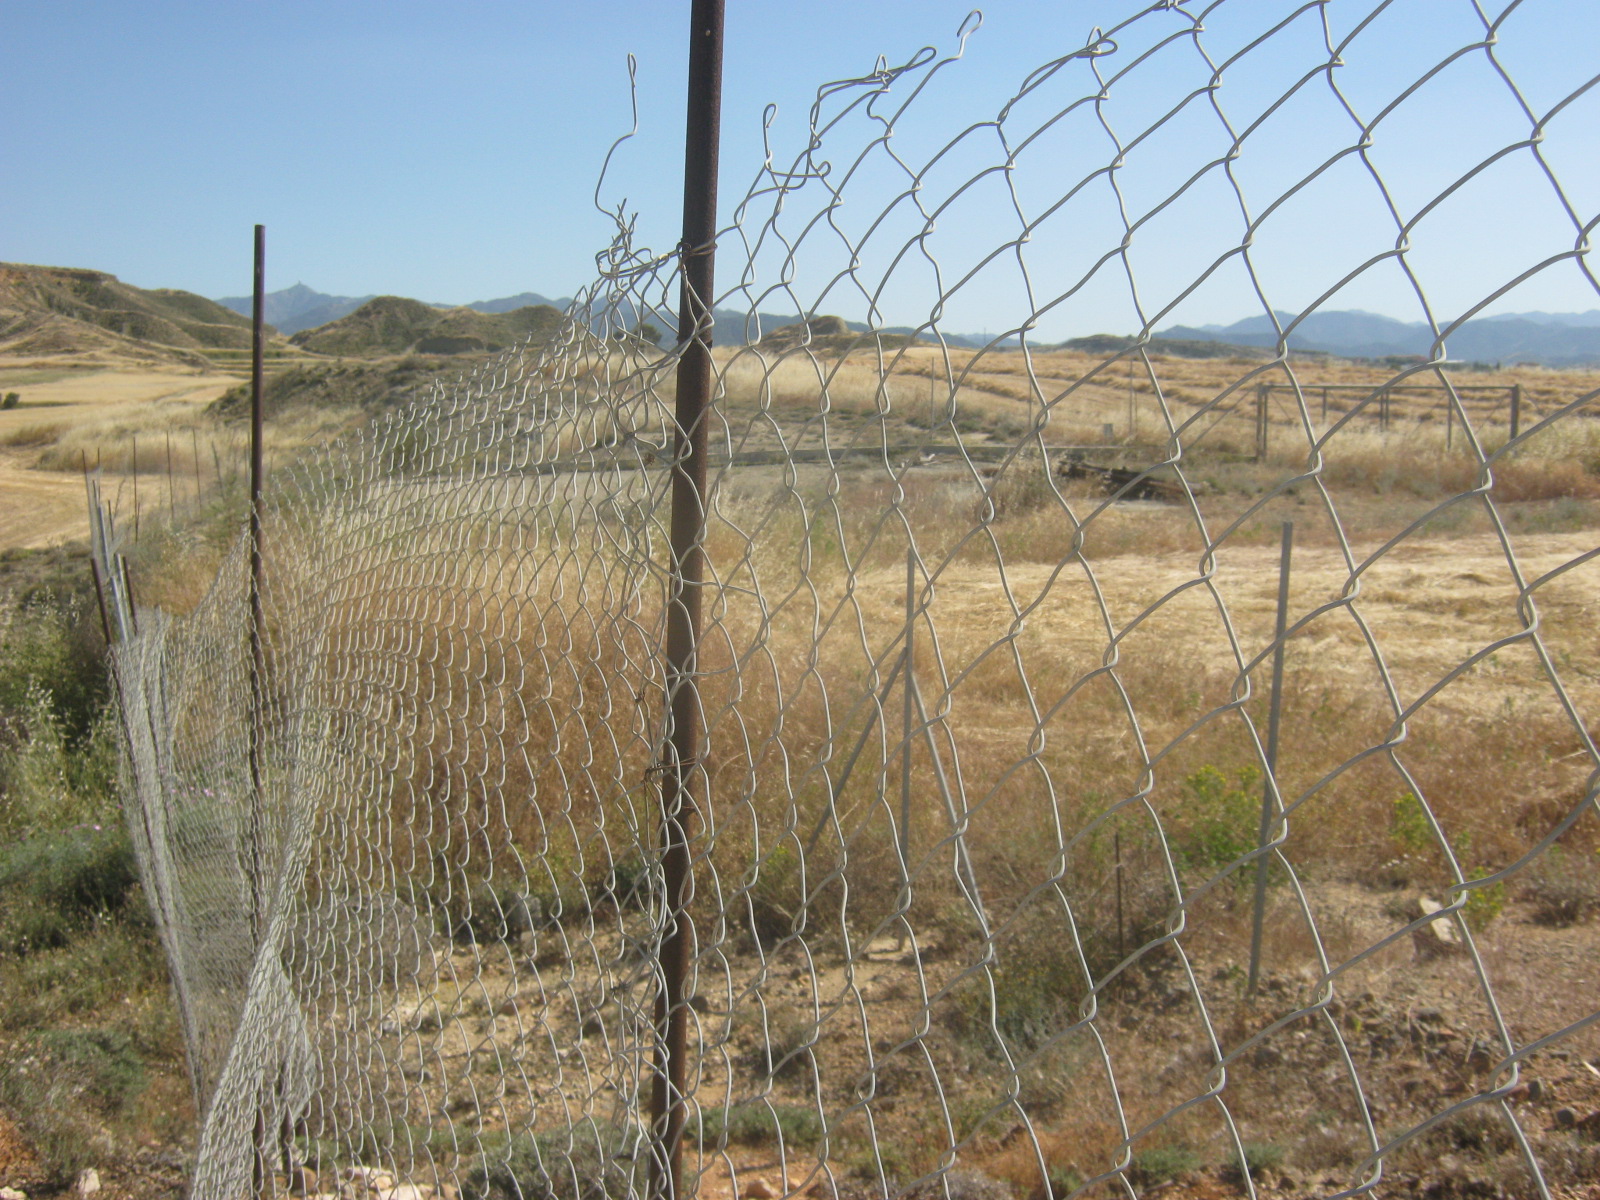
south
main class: Grassland
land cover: Spontaneously vegetated surfaces
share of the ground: > 75 %
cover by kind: herbaceous plants 75 %, unconsolidated bare surface 20 %, shrubs 5 %
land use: Agriculture (excluding fallow land and kitchen gardens)
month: May
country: CY
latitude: 35.0617
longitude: 33.1993
